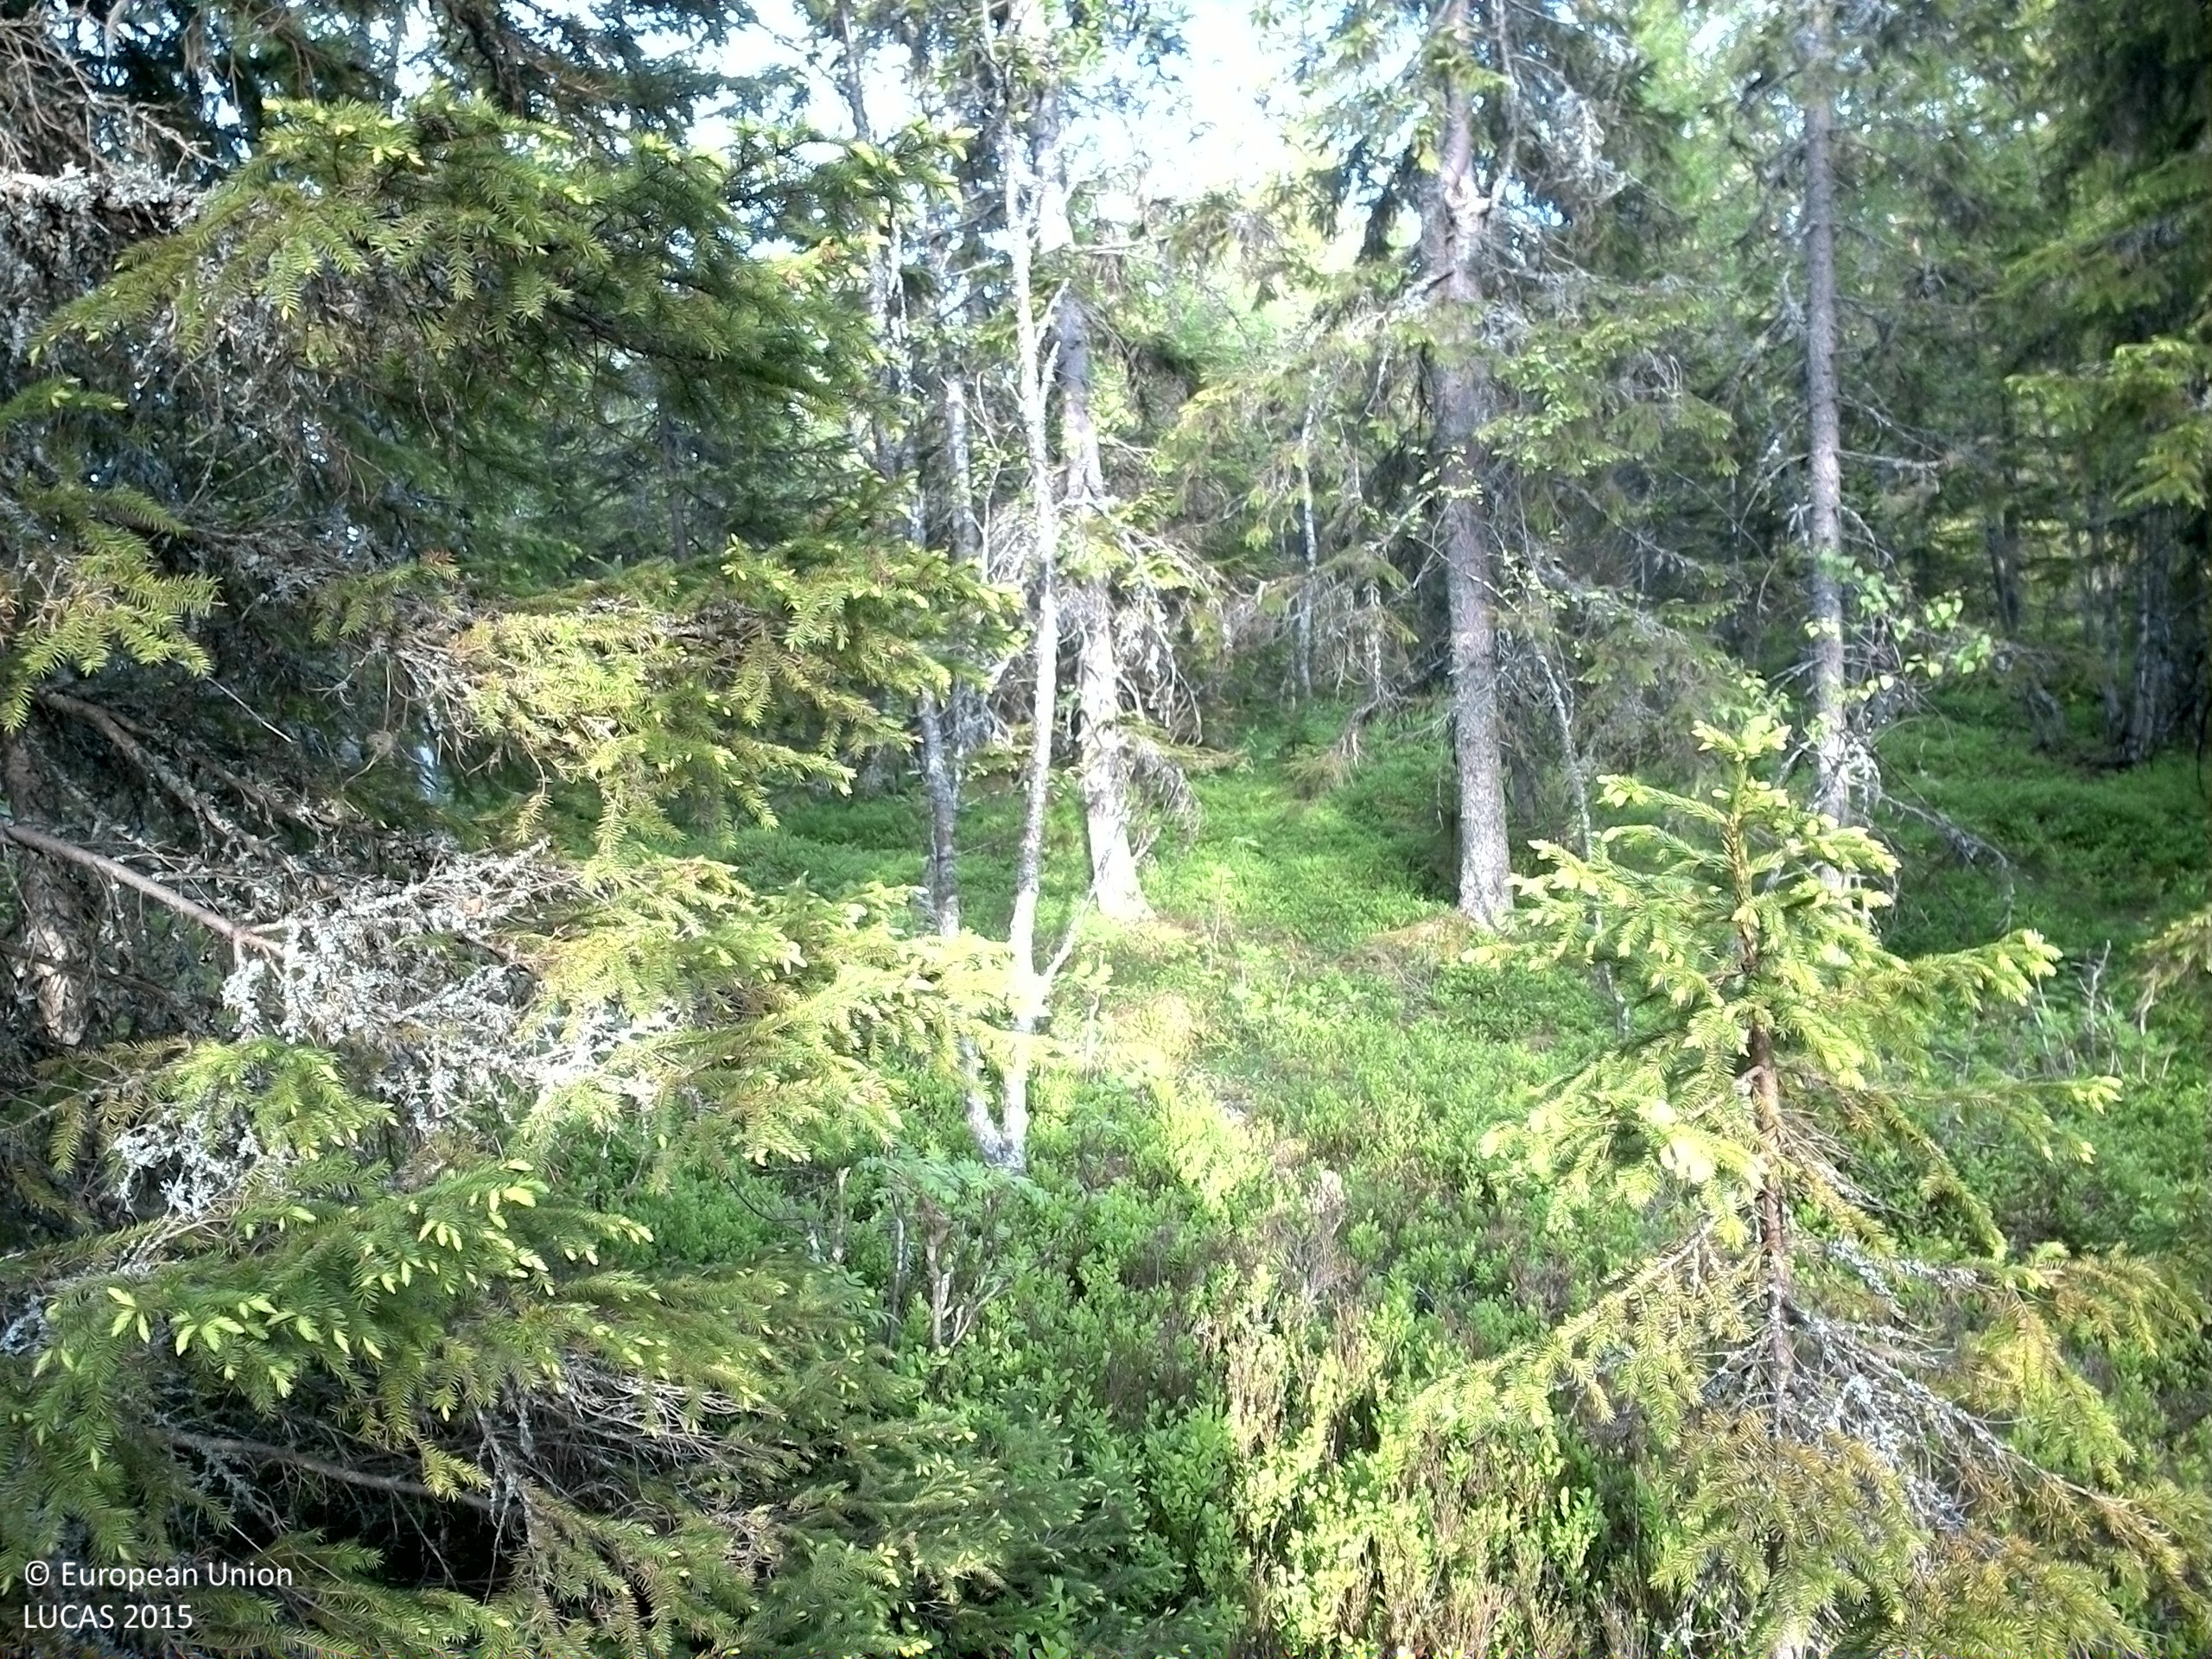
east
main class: Woodland
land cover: Other coniferous woodland
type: boreal forest
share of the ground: 25 - 50 %
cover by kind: shrubs 60 %, coniferous forest trees 25 %, lichens and mosses 10 %, broadleaved forest trees 5 %
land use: Forestry
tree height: > 5 m
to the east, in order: Other coniferous woodland; Spruce dominated coniferous woodland; Spruce dominated mixed woodland; Pine dominated coniferous woodland; Spruce dominated mixed woodland
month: June
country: SE
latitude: 62.6395
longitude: 17.5664
